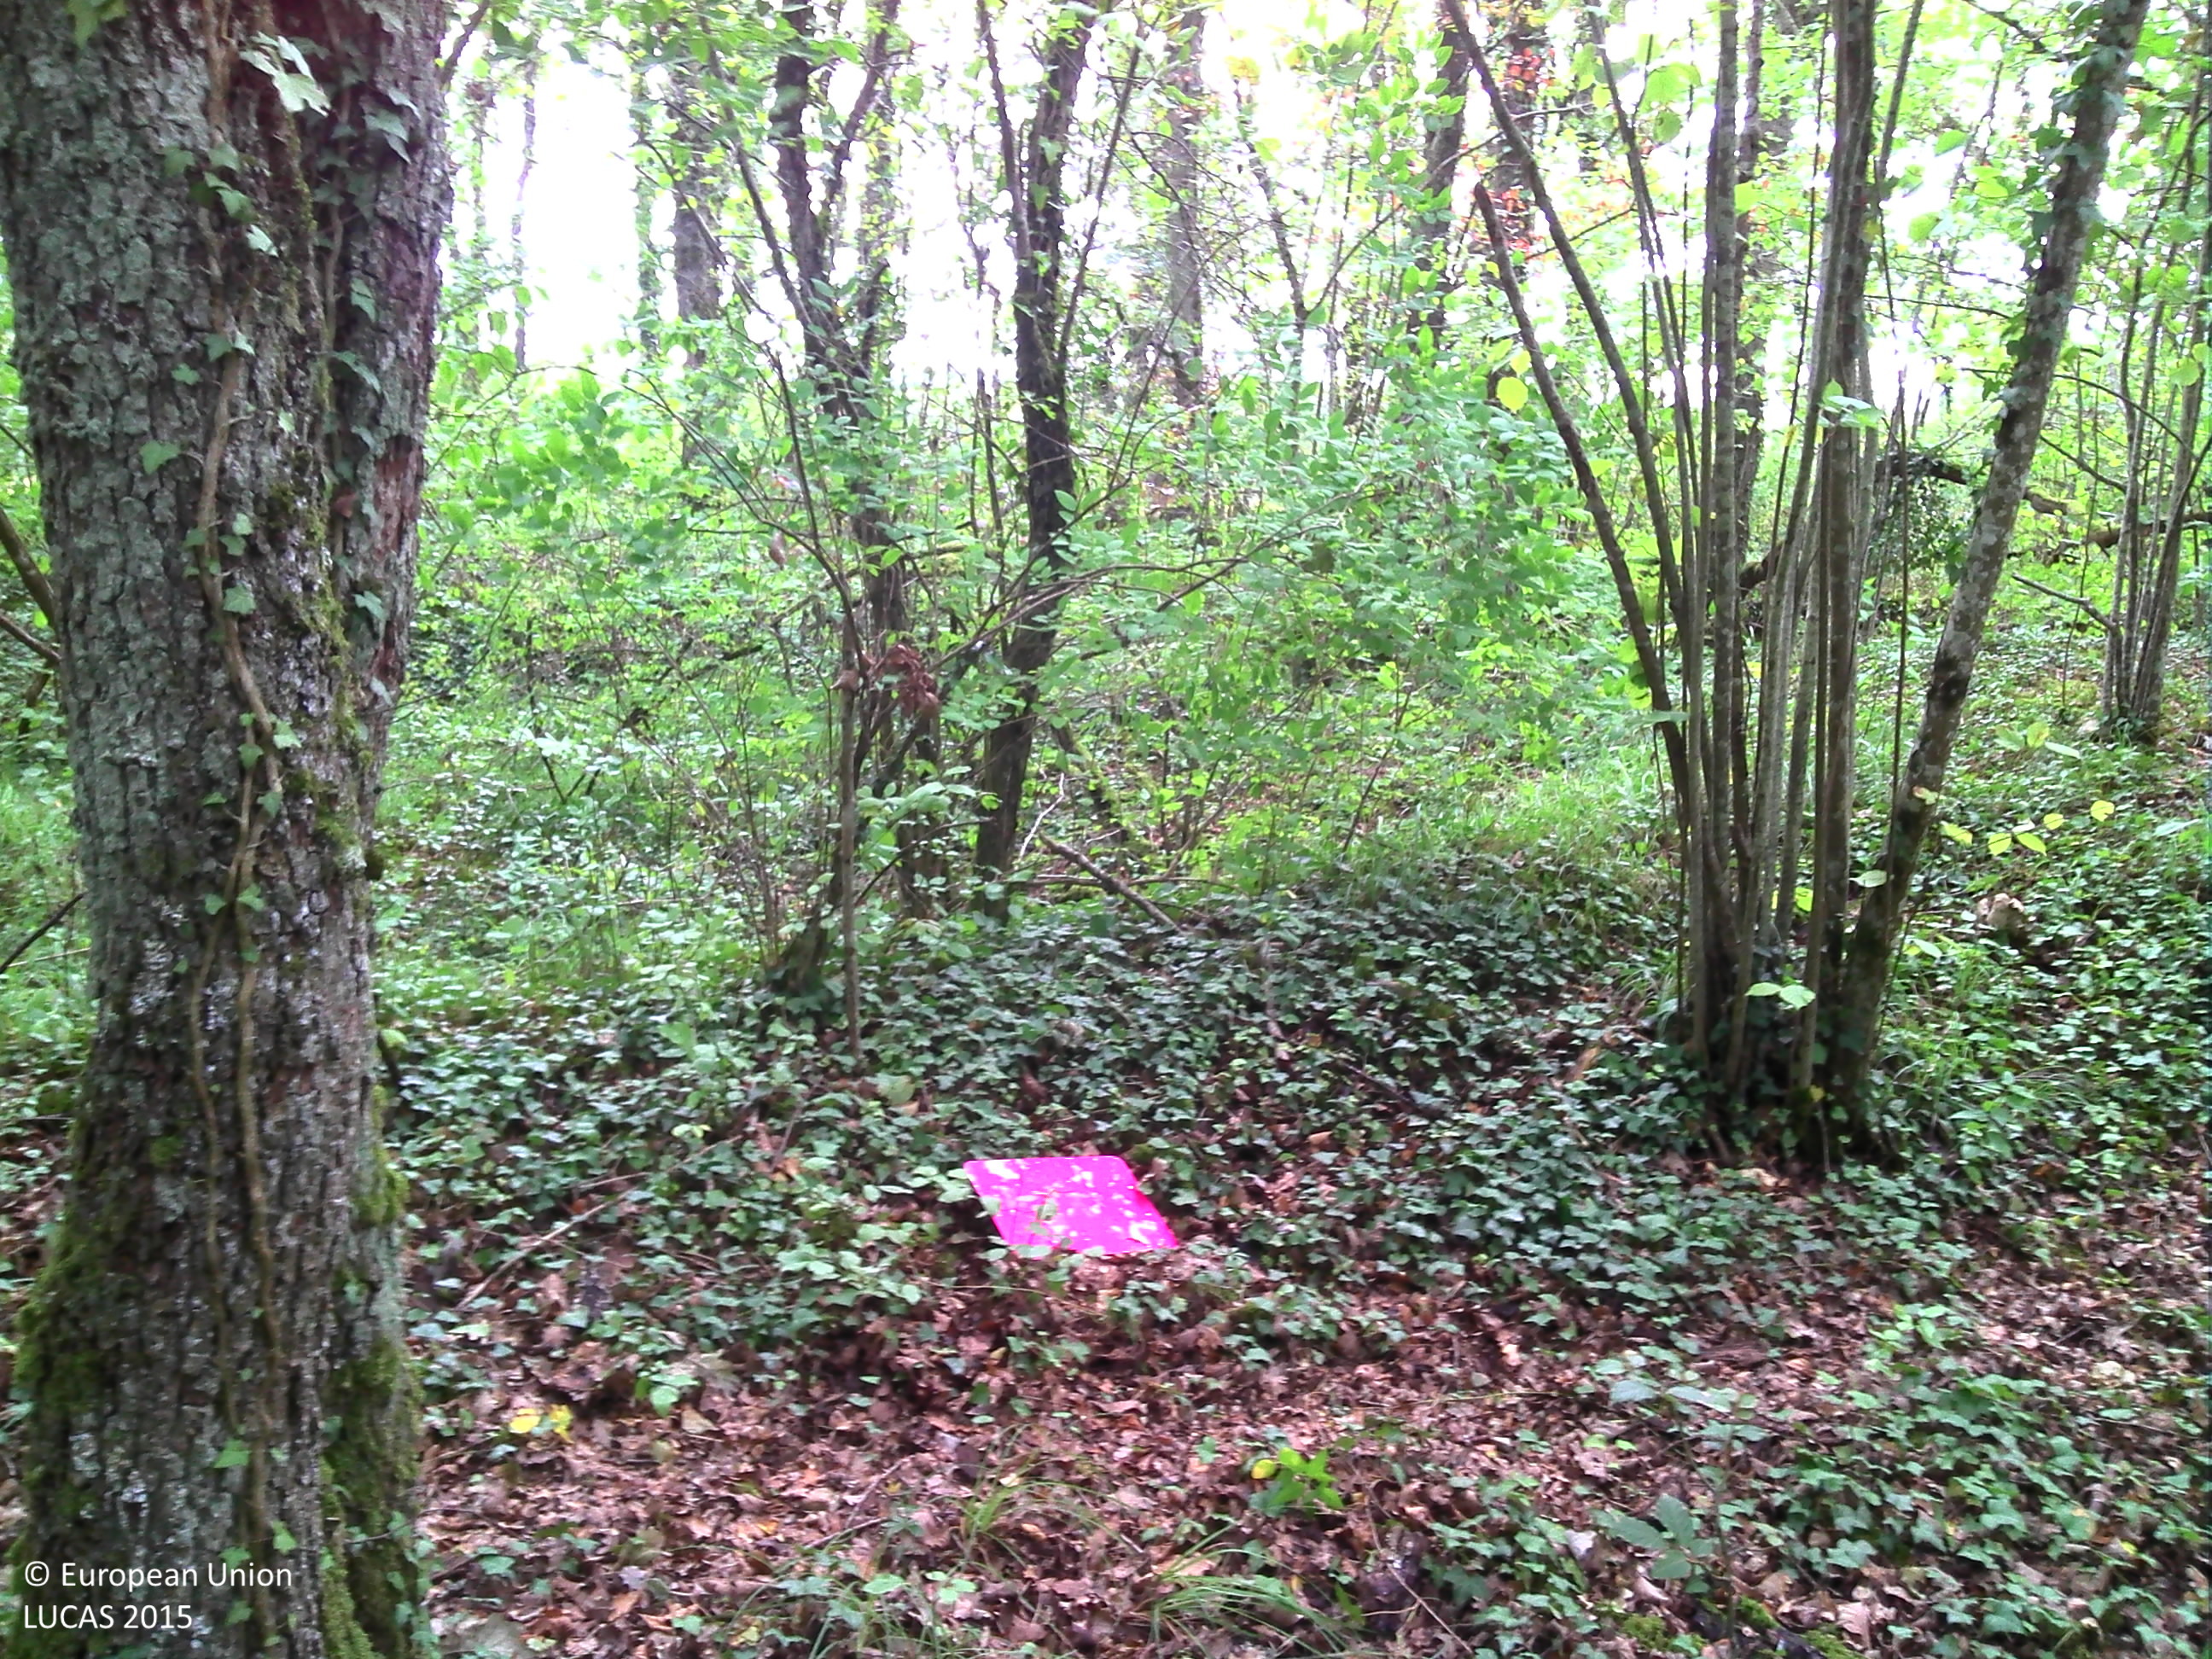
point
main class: Woodland
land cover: Broadleaved woodland
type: mesophytic deciduous forest
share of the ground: > 75 %
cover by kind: broadleaved forest trees 80 %, herbaceous plants 10 %, shrubs 5 %, lichens and mosses 5 %
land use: Forestry
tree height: > 5 m
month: September
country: FR
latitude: 48.2201
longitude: 4.6545
